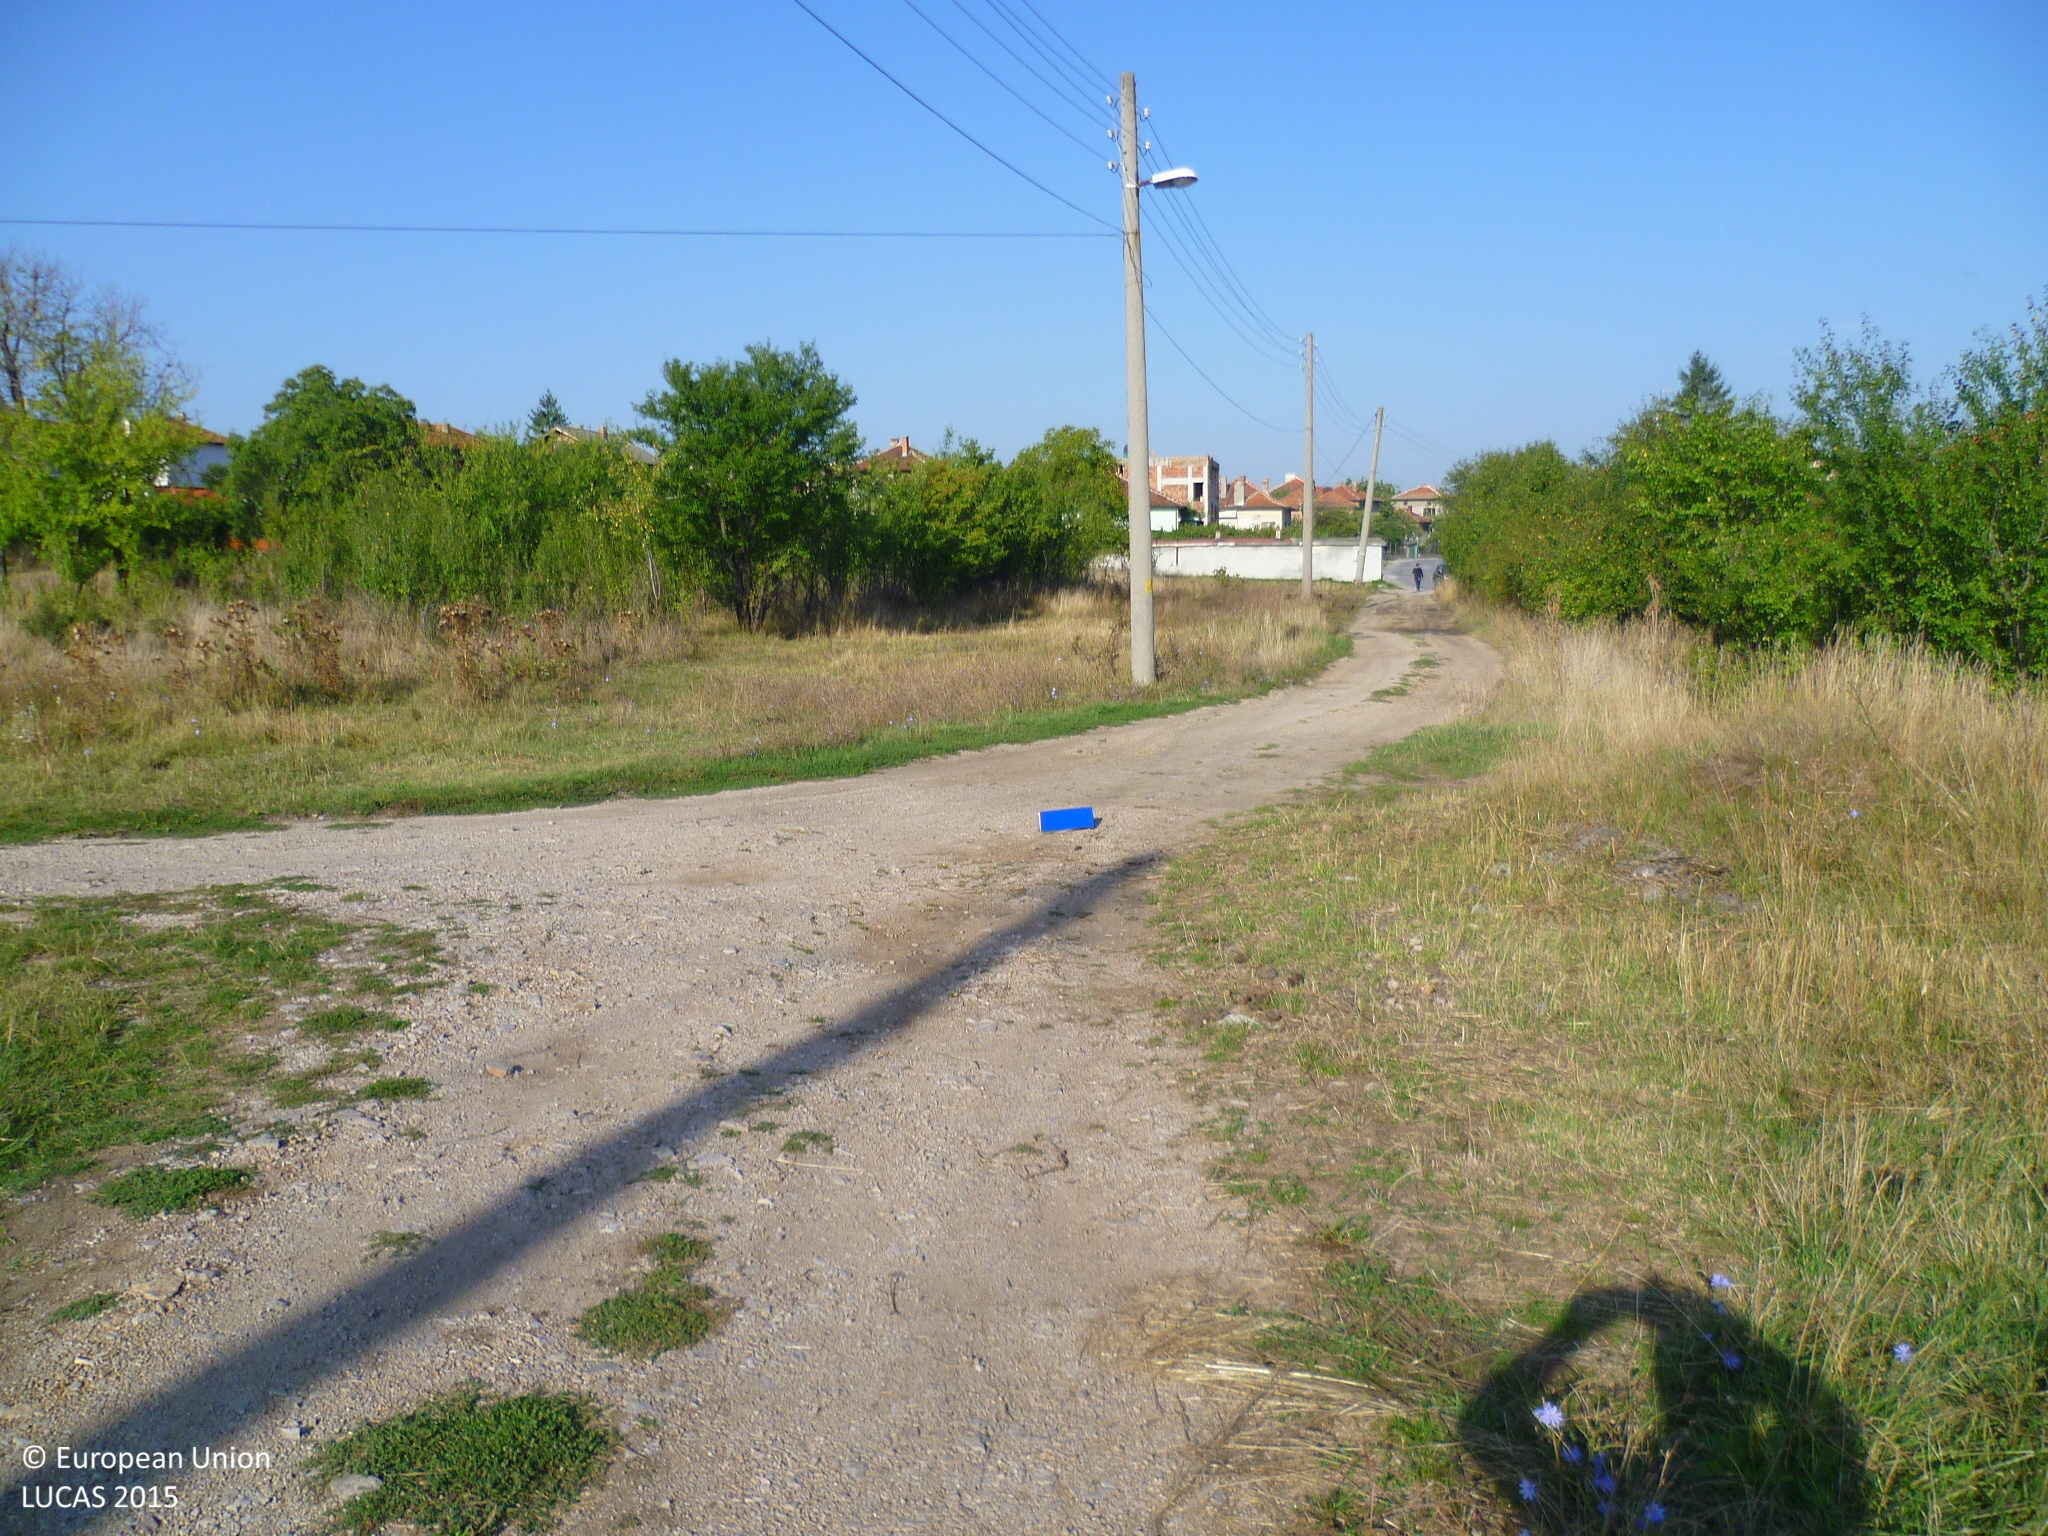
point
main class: Grassland
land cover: Grassland without tree/shrub cover
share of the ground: > 75 %
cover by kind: herbaceous plants 90 %, unconsolidated bare surface 10 %
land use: Agriculture (excluding fallow land and kitchen gardens)
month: September
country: BG
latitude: 42.9171
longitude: 22.9304
